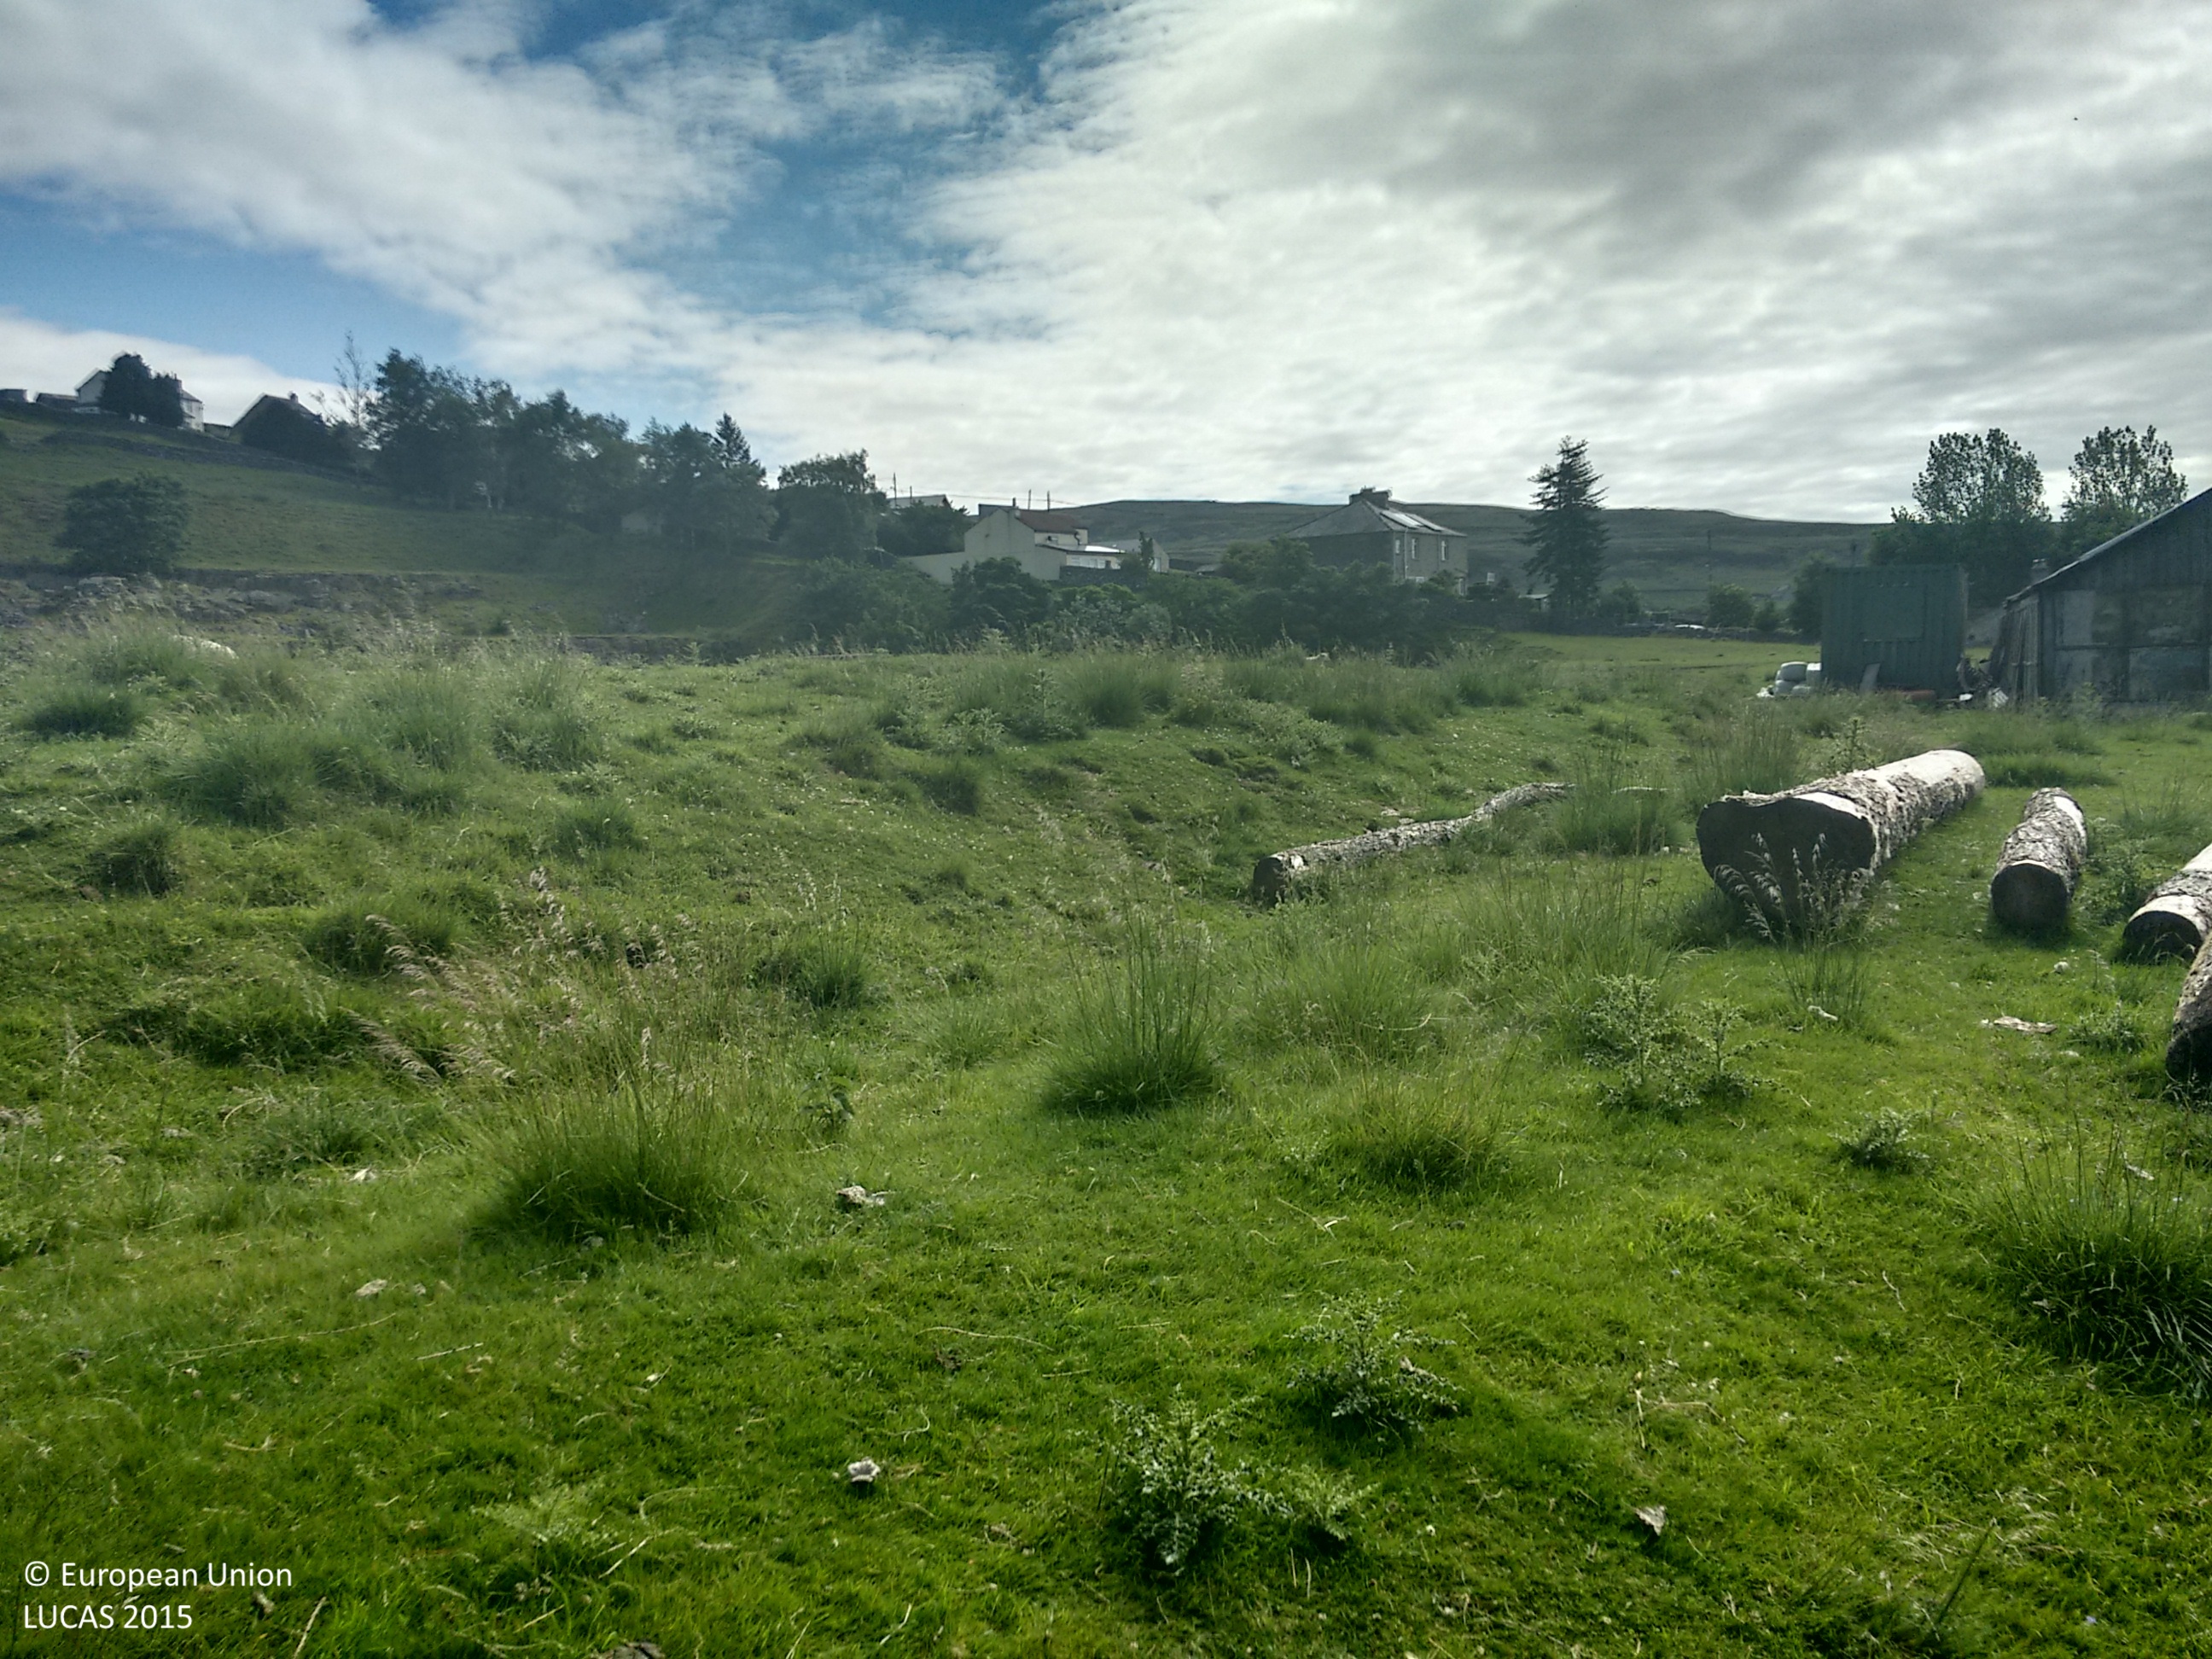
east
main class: Grassland
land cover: Grassland without tree/shrub cover
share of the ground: > 75 %
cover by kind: herbaceous plants 100 %
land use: Agriculture (excluding fallow land and kitchen gardens)
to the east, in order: Grassland without tree/shrub cover; Broadleaved woodland; Artificial constructions in urban areas; Grassland without tree/shrub cover
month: June
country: GB
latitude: 54.7486
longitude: -2.0023
